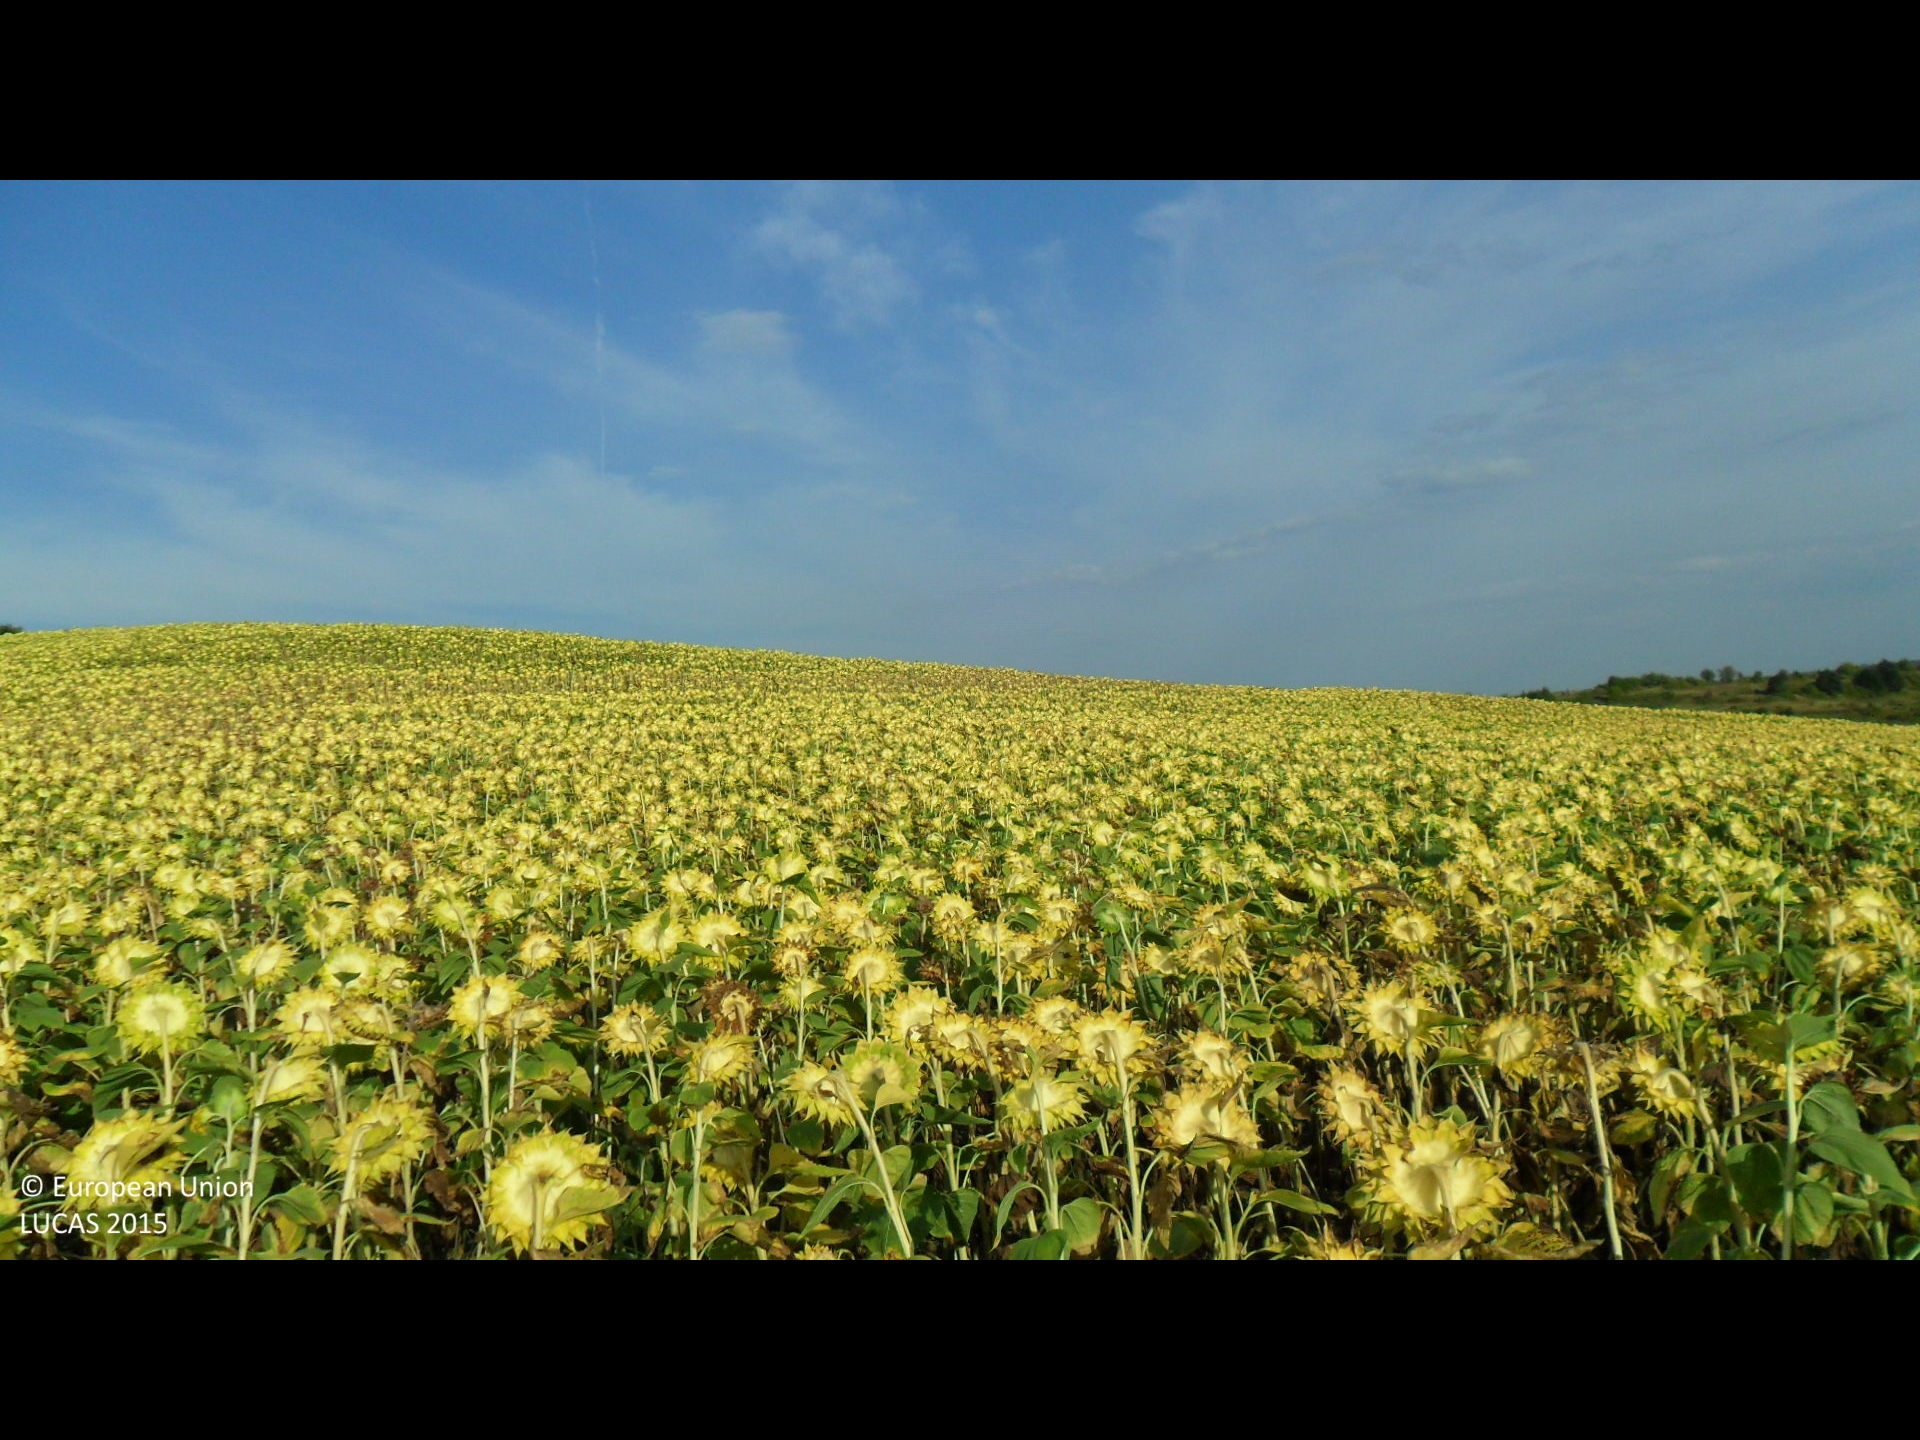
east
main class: Cropland
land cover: Sunflower
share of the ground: > 75 %
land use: Agriculture (excluding fallow land and kitchen gardens)
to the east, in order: Sunflower; Shruby margins; Sunflower
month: August
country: BG
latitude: 43.3692
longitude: 26.1502
